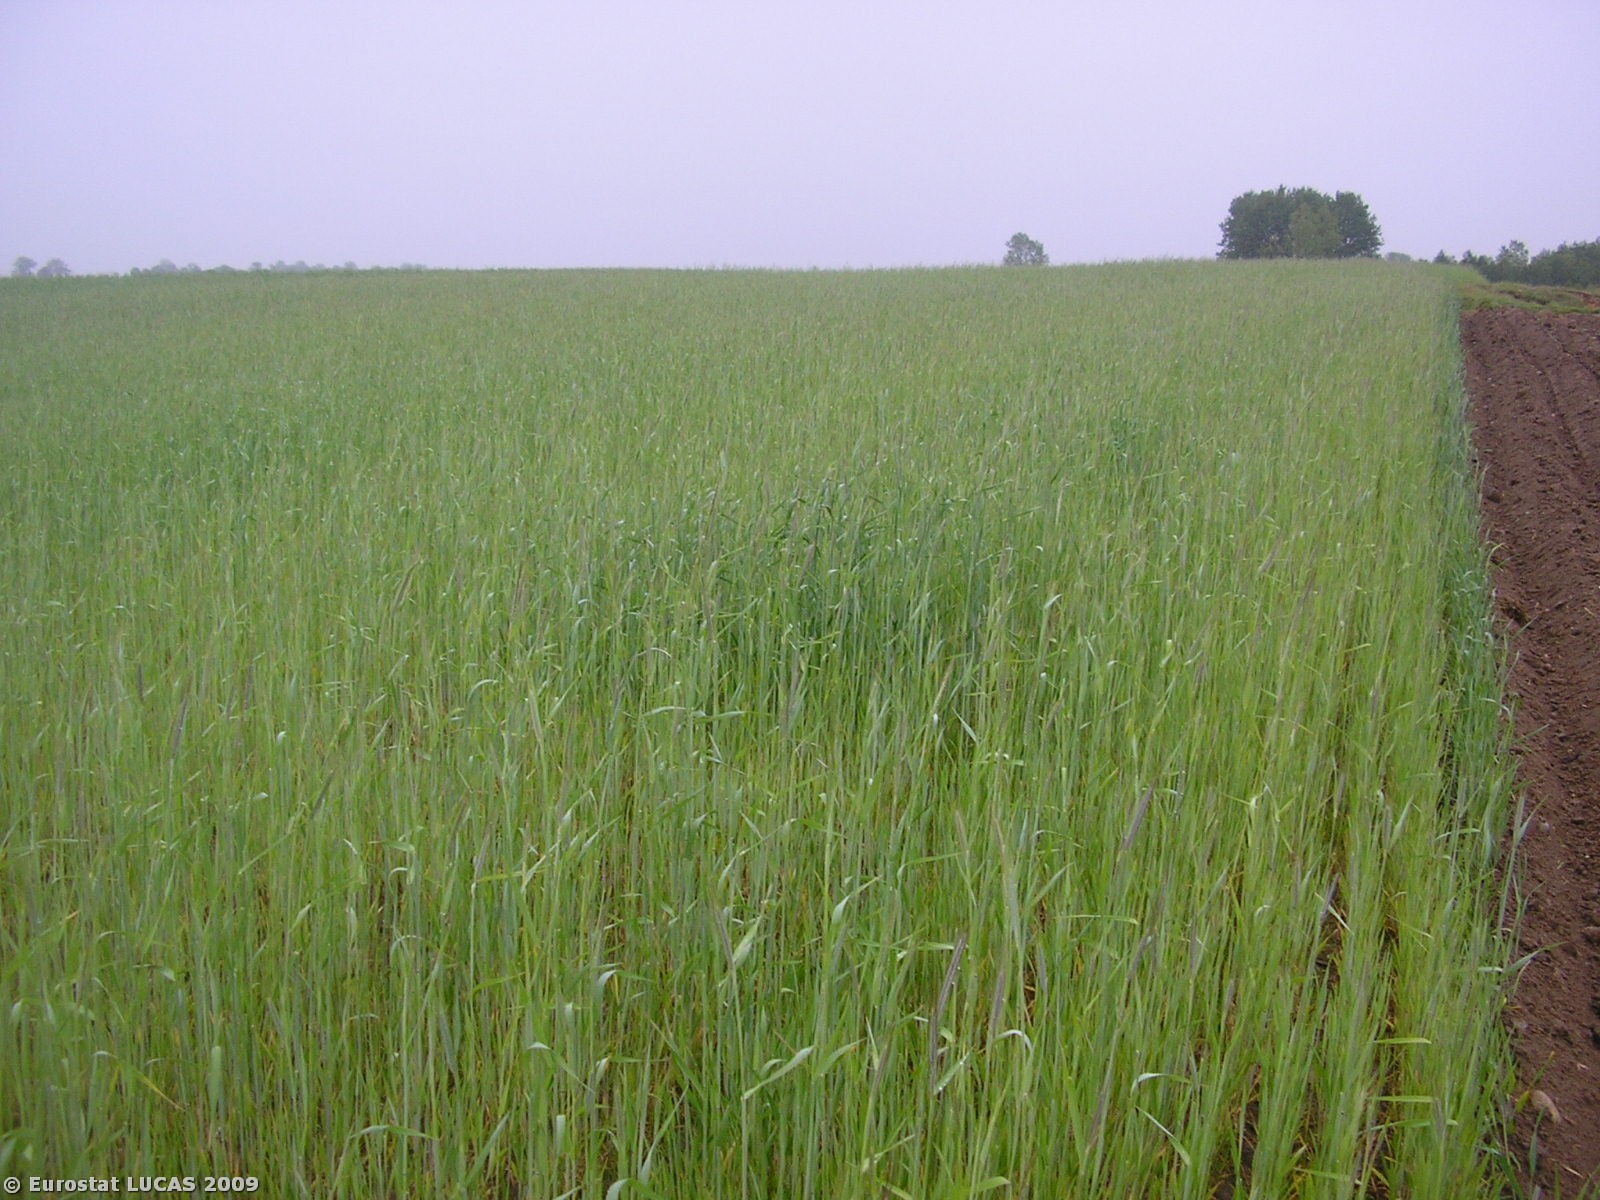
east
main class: Cropland
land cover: Rye
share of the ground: > 75 %
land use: Agriculture (excluding fallow land and kitchen gardens)
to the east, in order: Rye
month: May
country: PL
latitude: 51.7892
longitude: 20.0220
